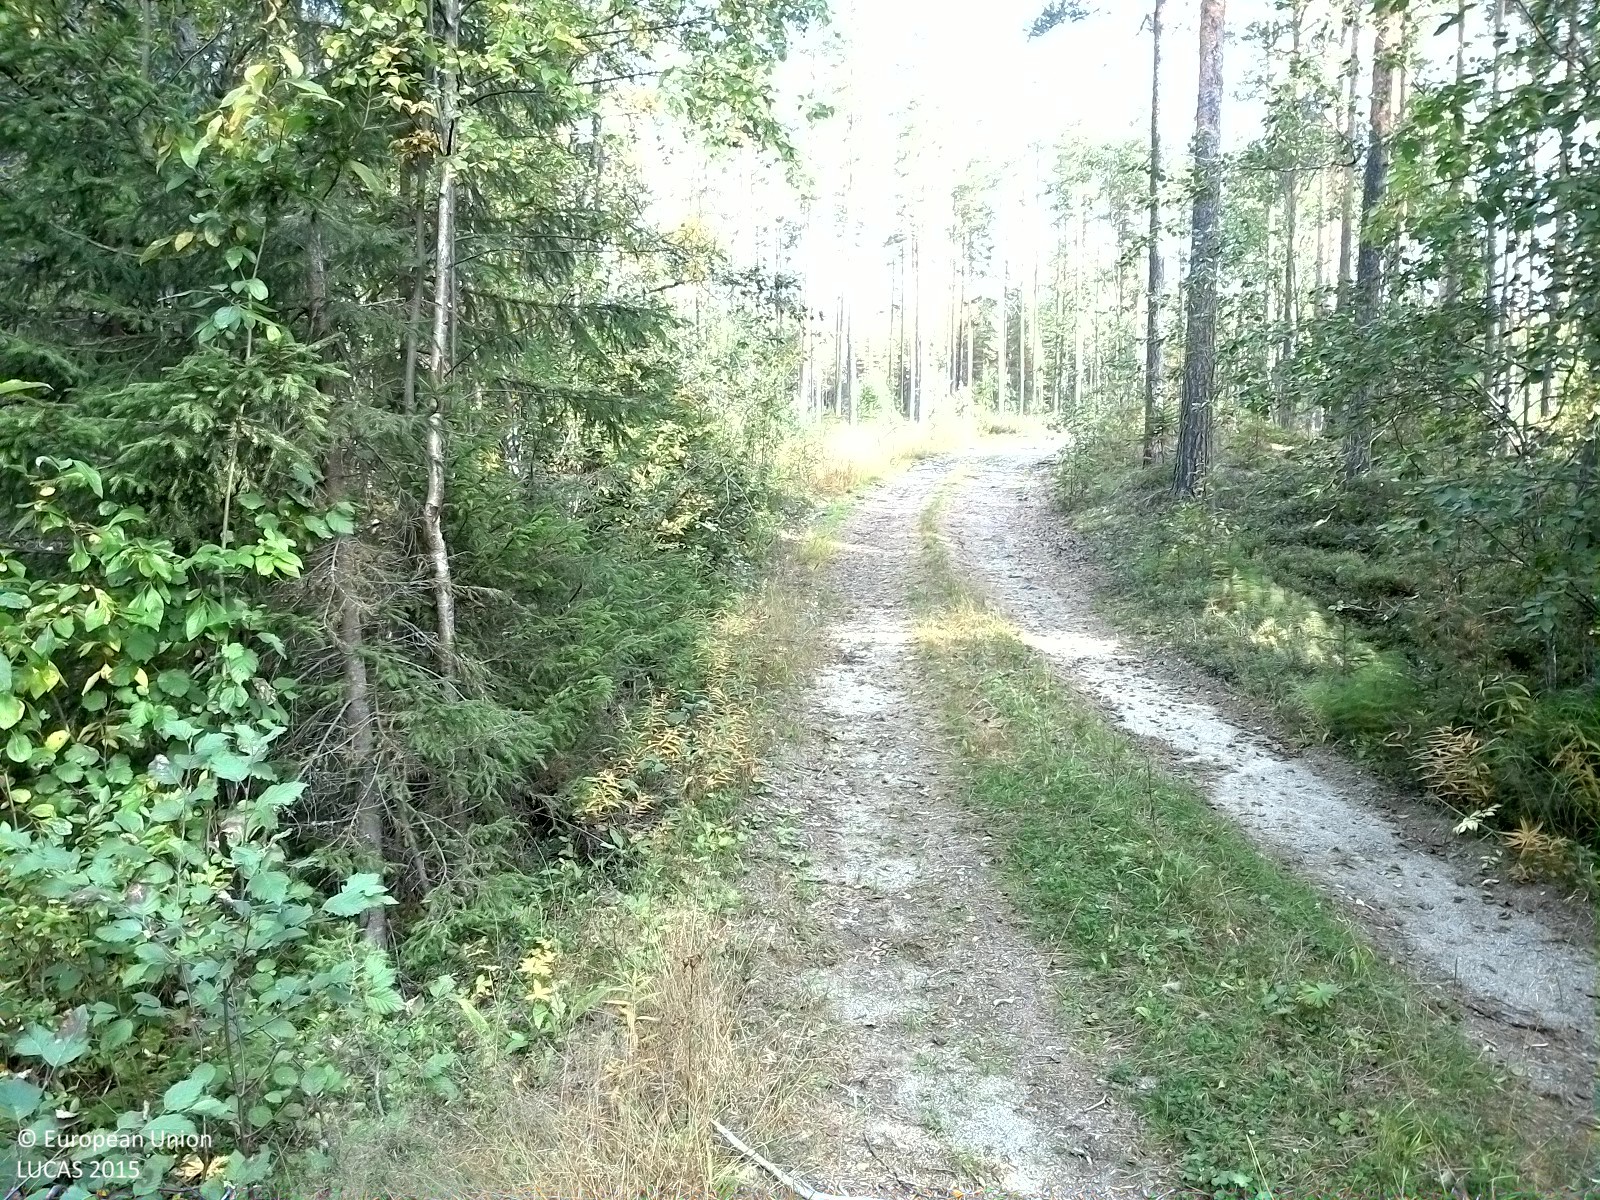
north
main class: Woodland
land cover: Spruce dominated mixed woodland
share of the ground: > 75 %
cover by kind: coniferous forest trees 40 %, broadleaved forest trees 35 %, shrubs 25 %
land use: Forestry
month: September
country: SE
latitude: 62.6035
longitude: 16.3876
